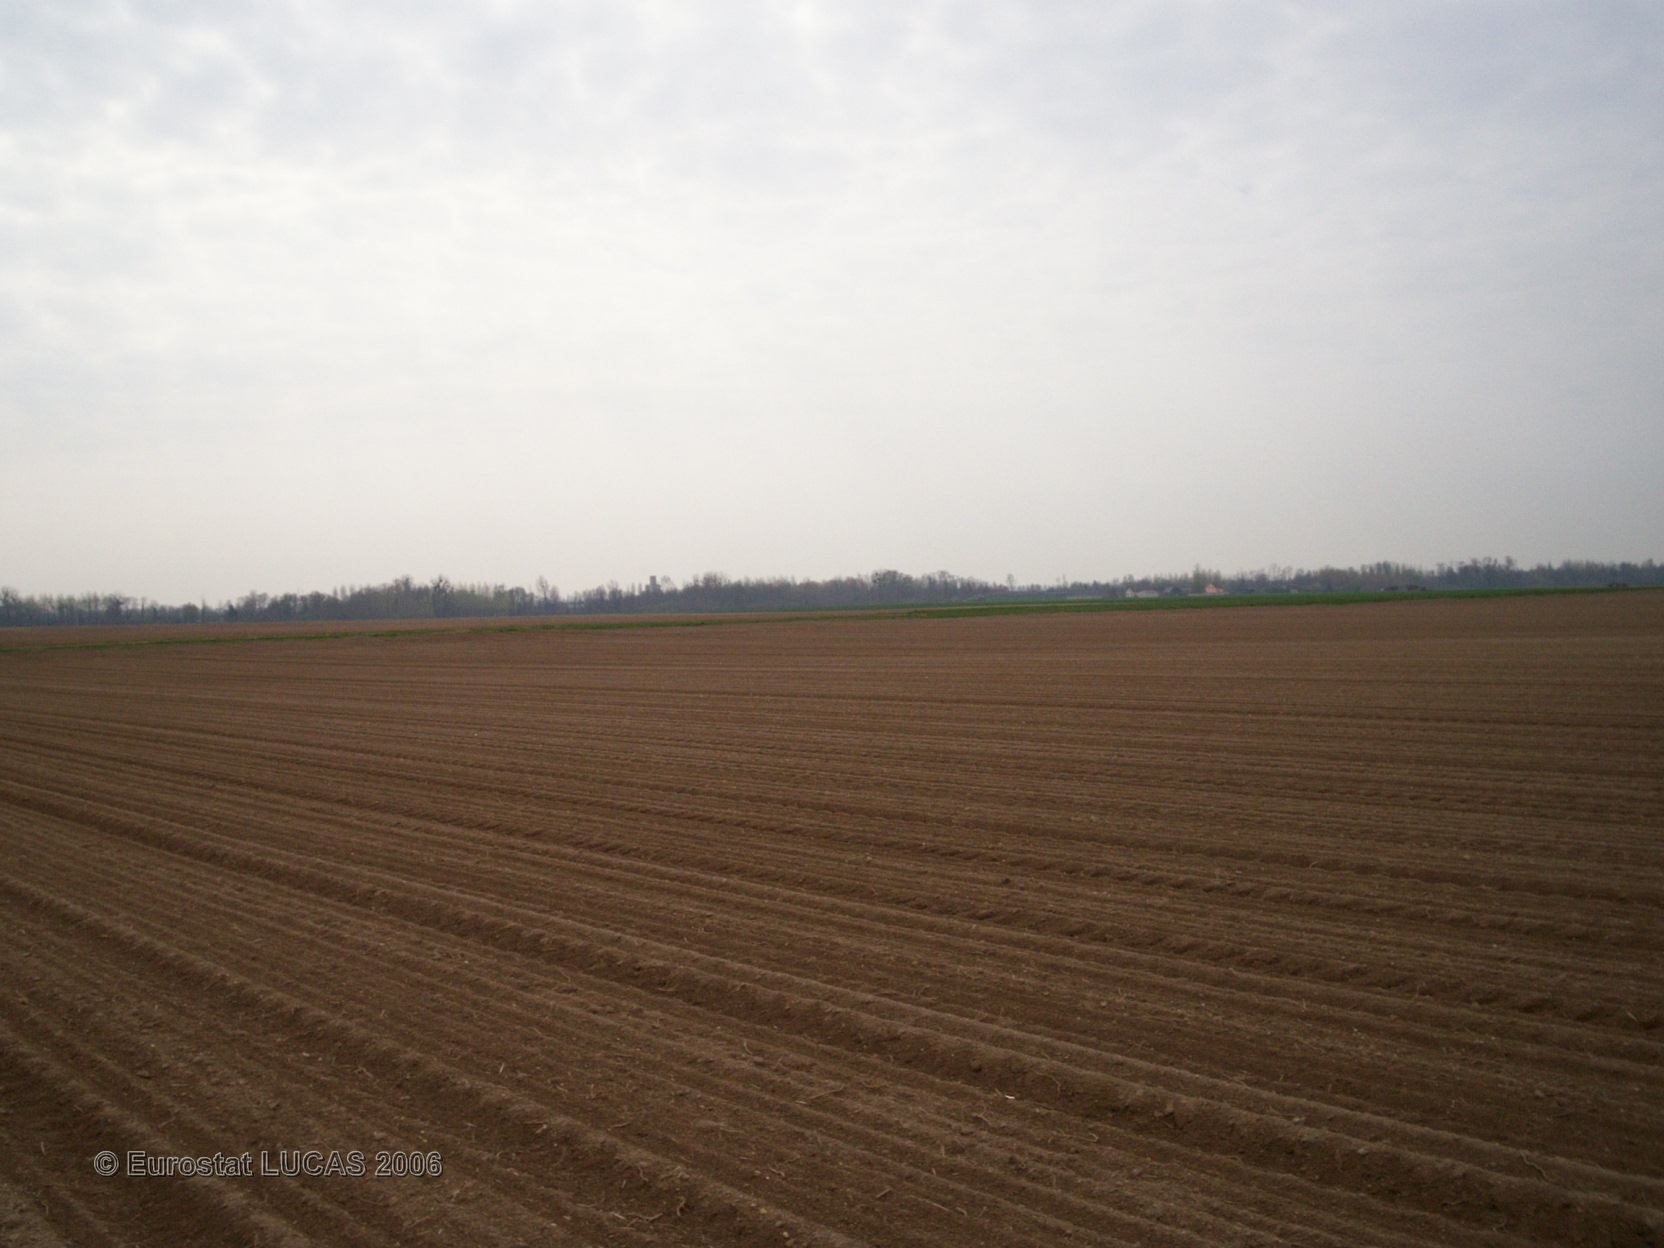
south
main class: Cropland
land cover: Sugar beet
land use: Agriculture (excluding fallow land and kitchen gardens)
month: April
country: FR
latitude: 48.6695
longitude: 3.9254
